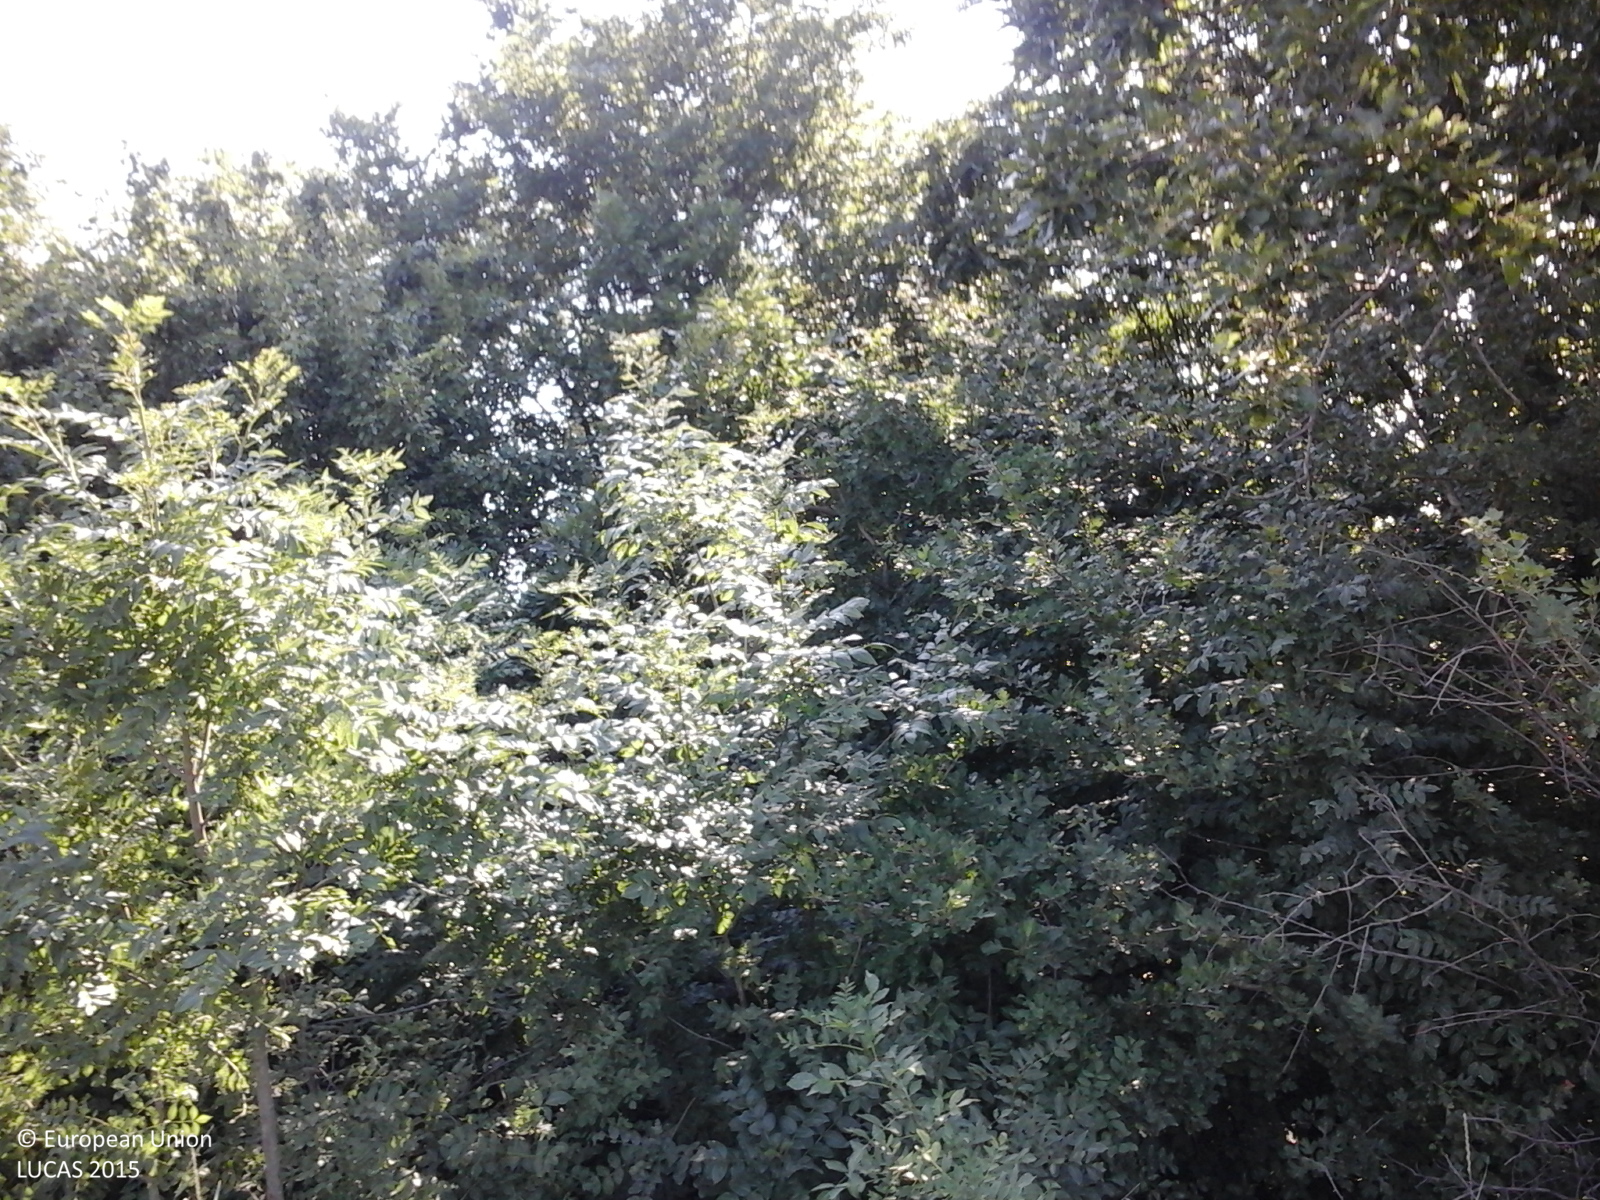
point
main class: Woodland
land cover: Broadleaved woodland
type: acidophilous oak and oak-birch forest
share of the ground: > 75 %
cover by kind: broadleaved forest trees 100 %
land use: Forestry
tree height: > 5 m
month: July
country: RO
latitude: 44.5148
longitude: 25.0141
